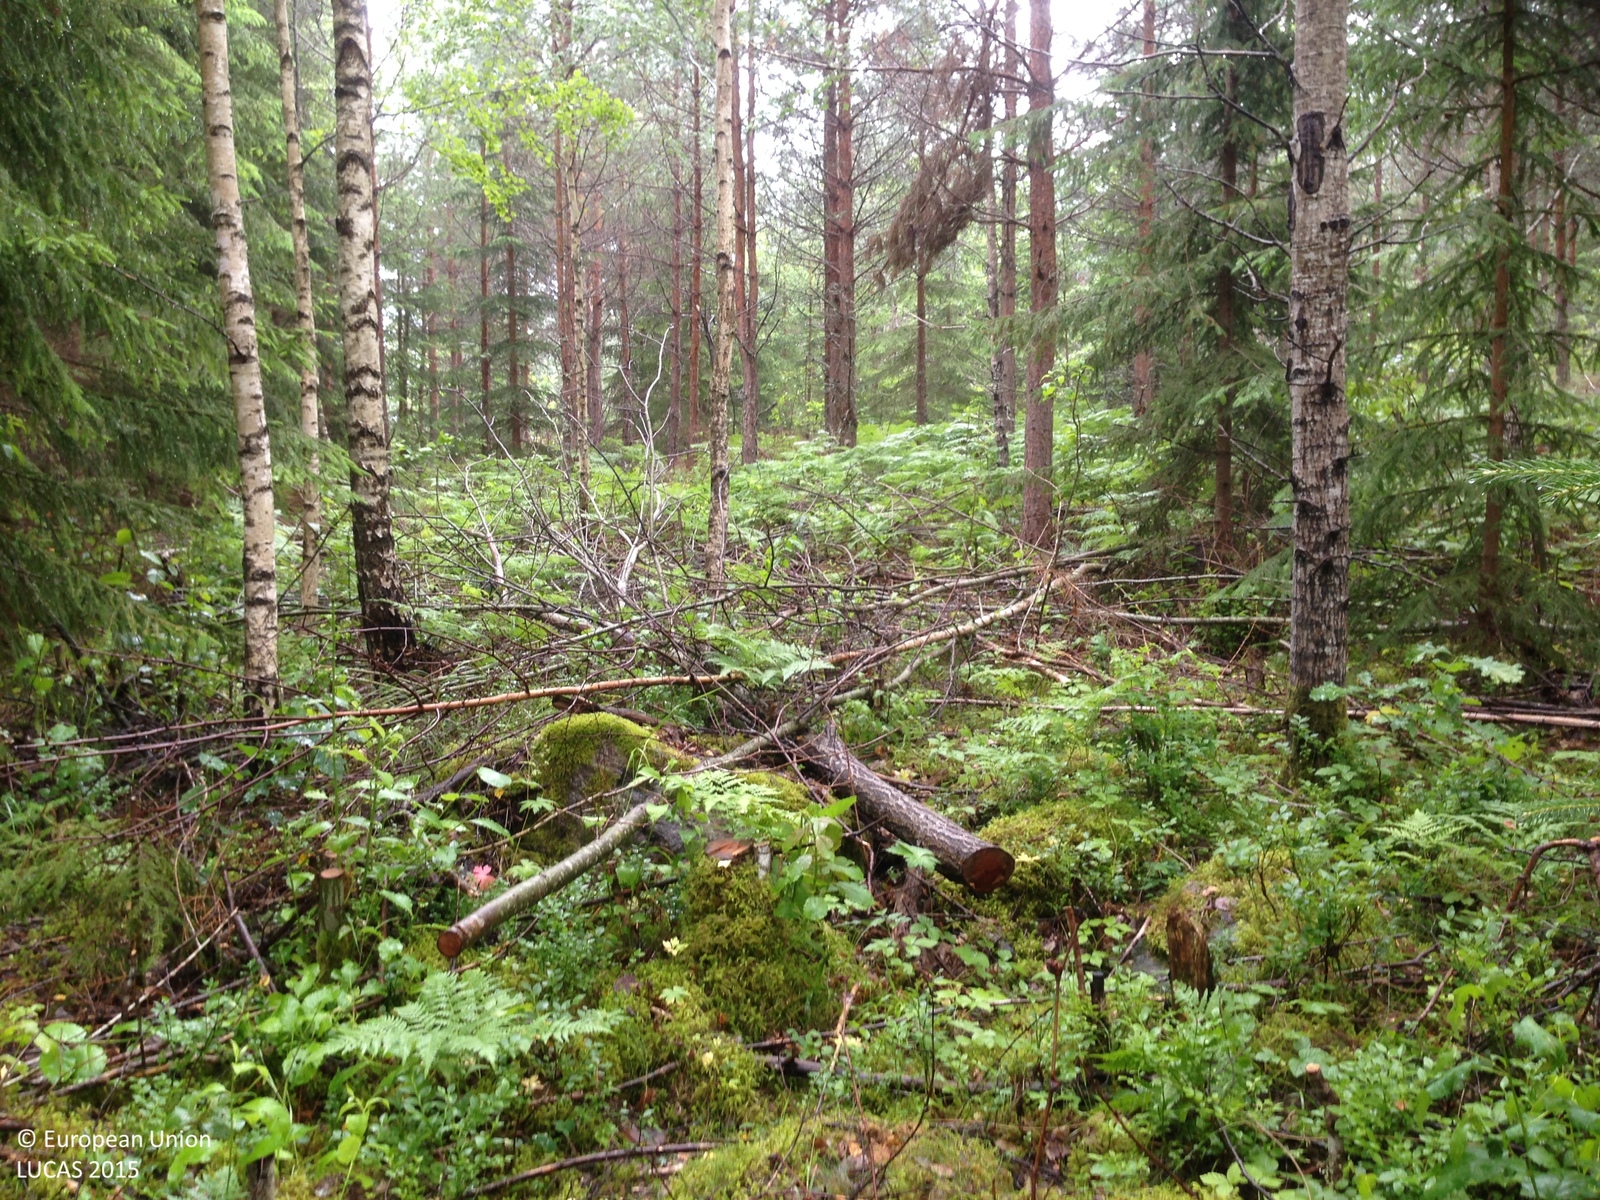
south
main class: Woodland
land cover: Spruce dominated mixed woodland
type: boreal forest
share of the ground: 50 - 75 %
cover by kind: coniferous forest trees 45 %, lichens and mosses 20 %, broadleaved forest trees 15 %, herbaceous plants 15 %, shrubs 5 %
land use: Forestry
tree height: > 5 m
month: July
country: SE
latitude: 59.8755
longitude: 18.6987
